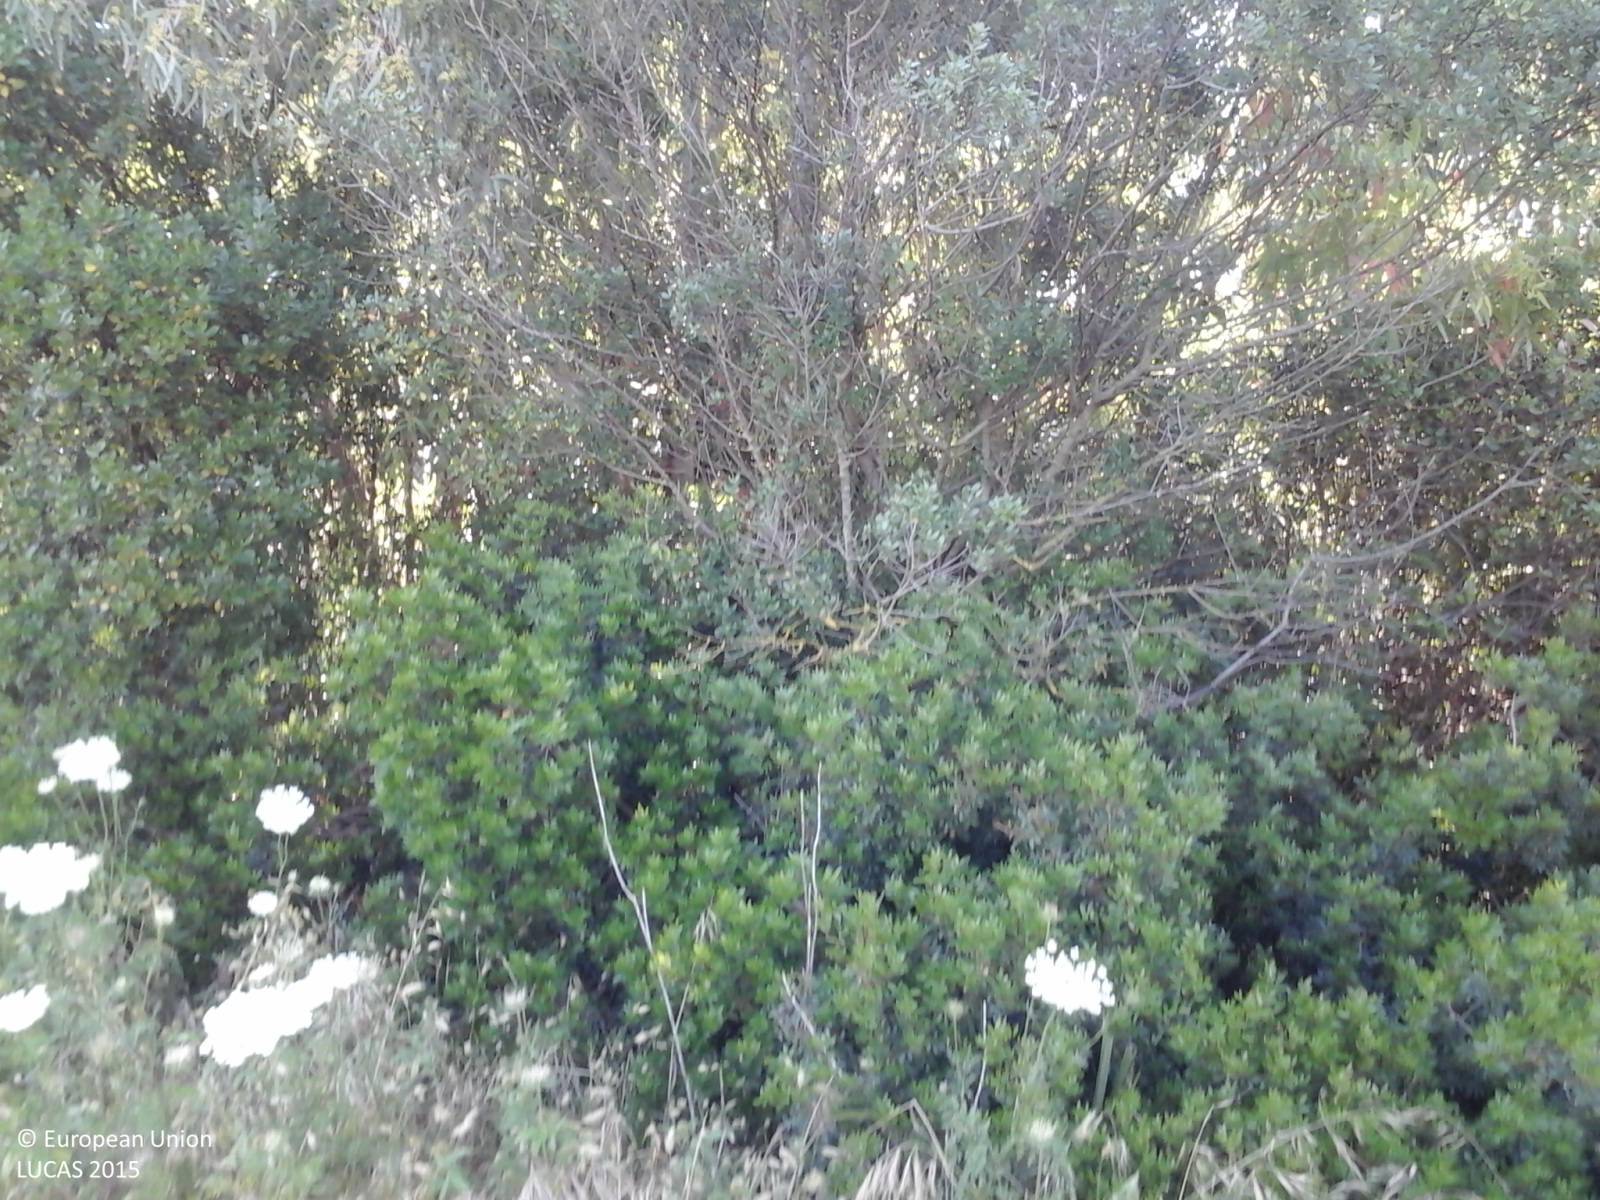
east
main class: Cropland
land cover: Lucerne
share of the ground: 50 - 75 %
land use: Agriculture (excluding fallow land and kitchen gardens)
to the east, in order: Lucerne; Grass margins; Broadleaved woodland; Grass margins; Paved roads, cycling and walking lanes; Grass margins; Fences; Broadleaved woodland; Grassland without tree/shrub cover; Electric lines; Tracks; Grassland without tree/shrub cover; Tracks; Grassland without tree/shrub cover
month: June
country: IT
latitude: 40.6704
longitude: 8.3871
